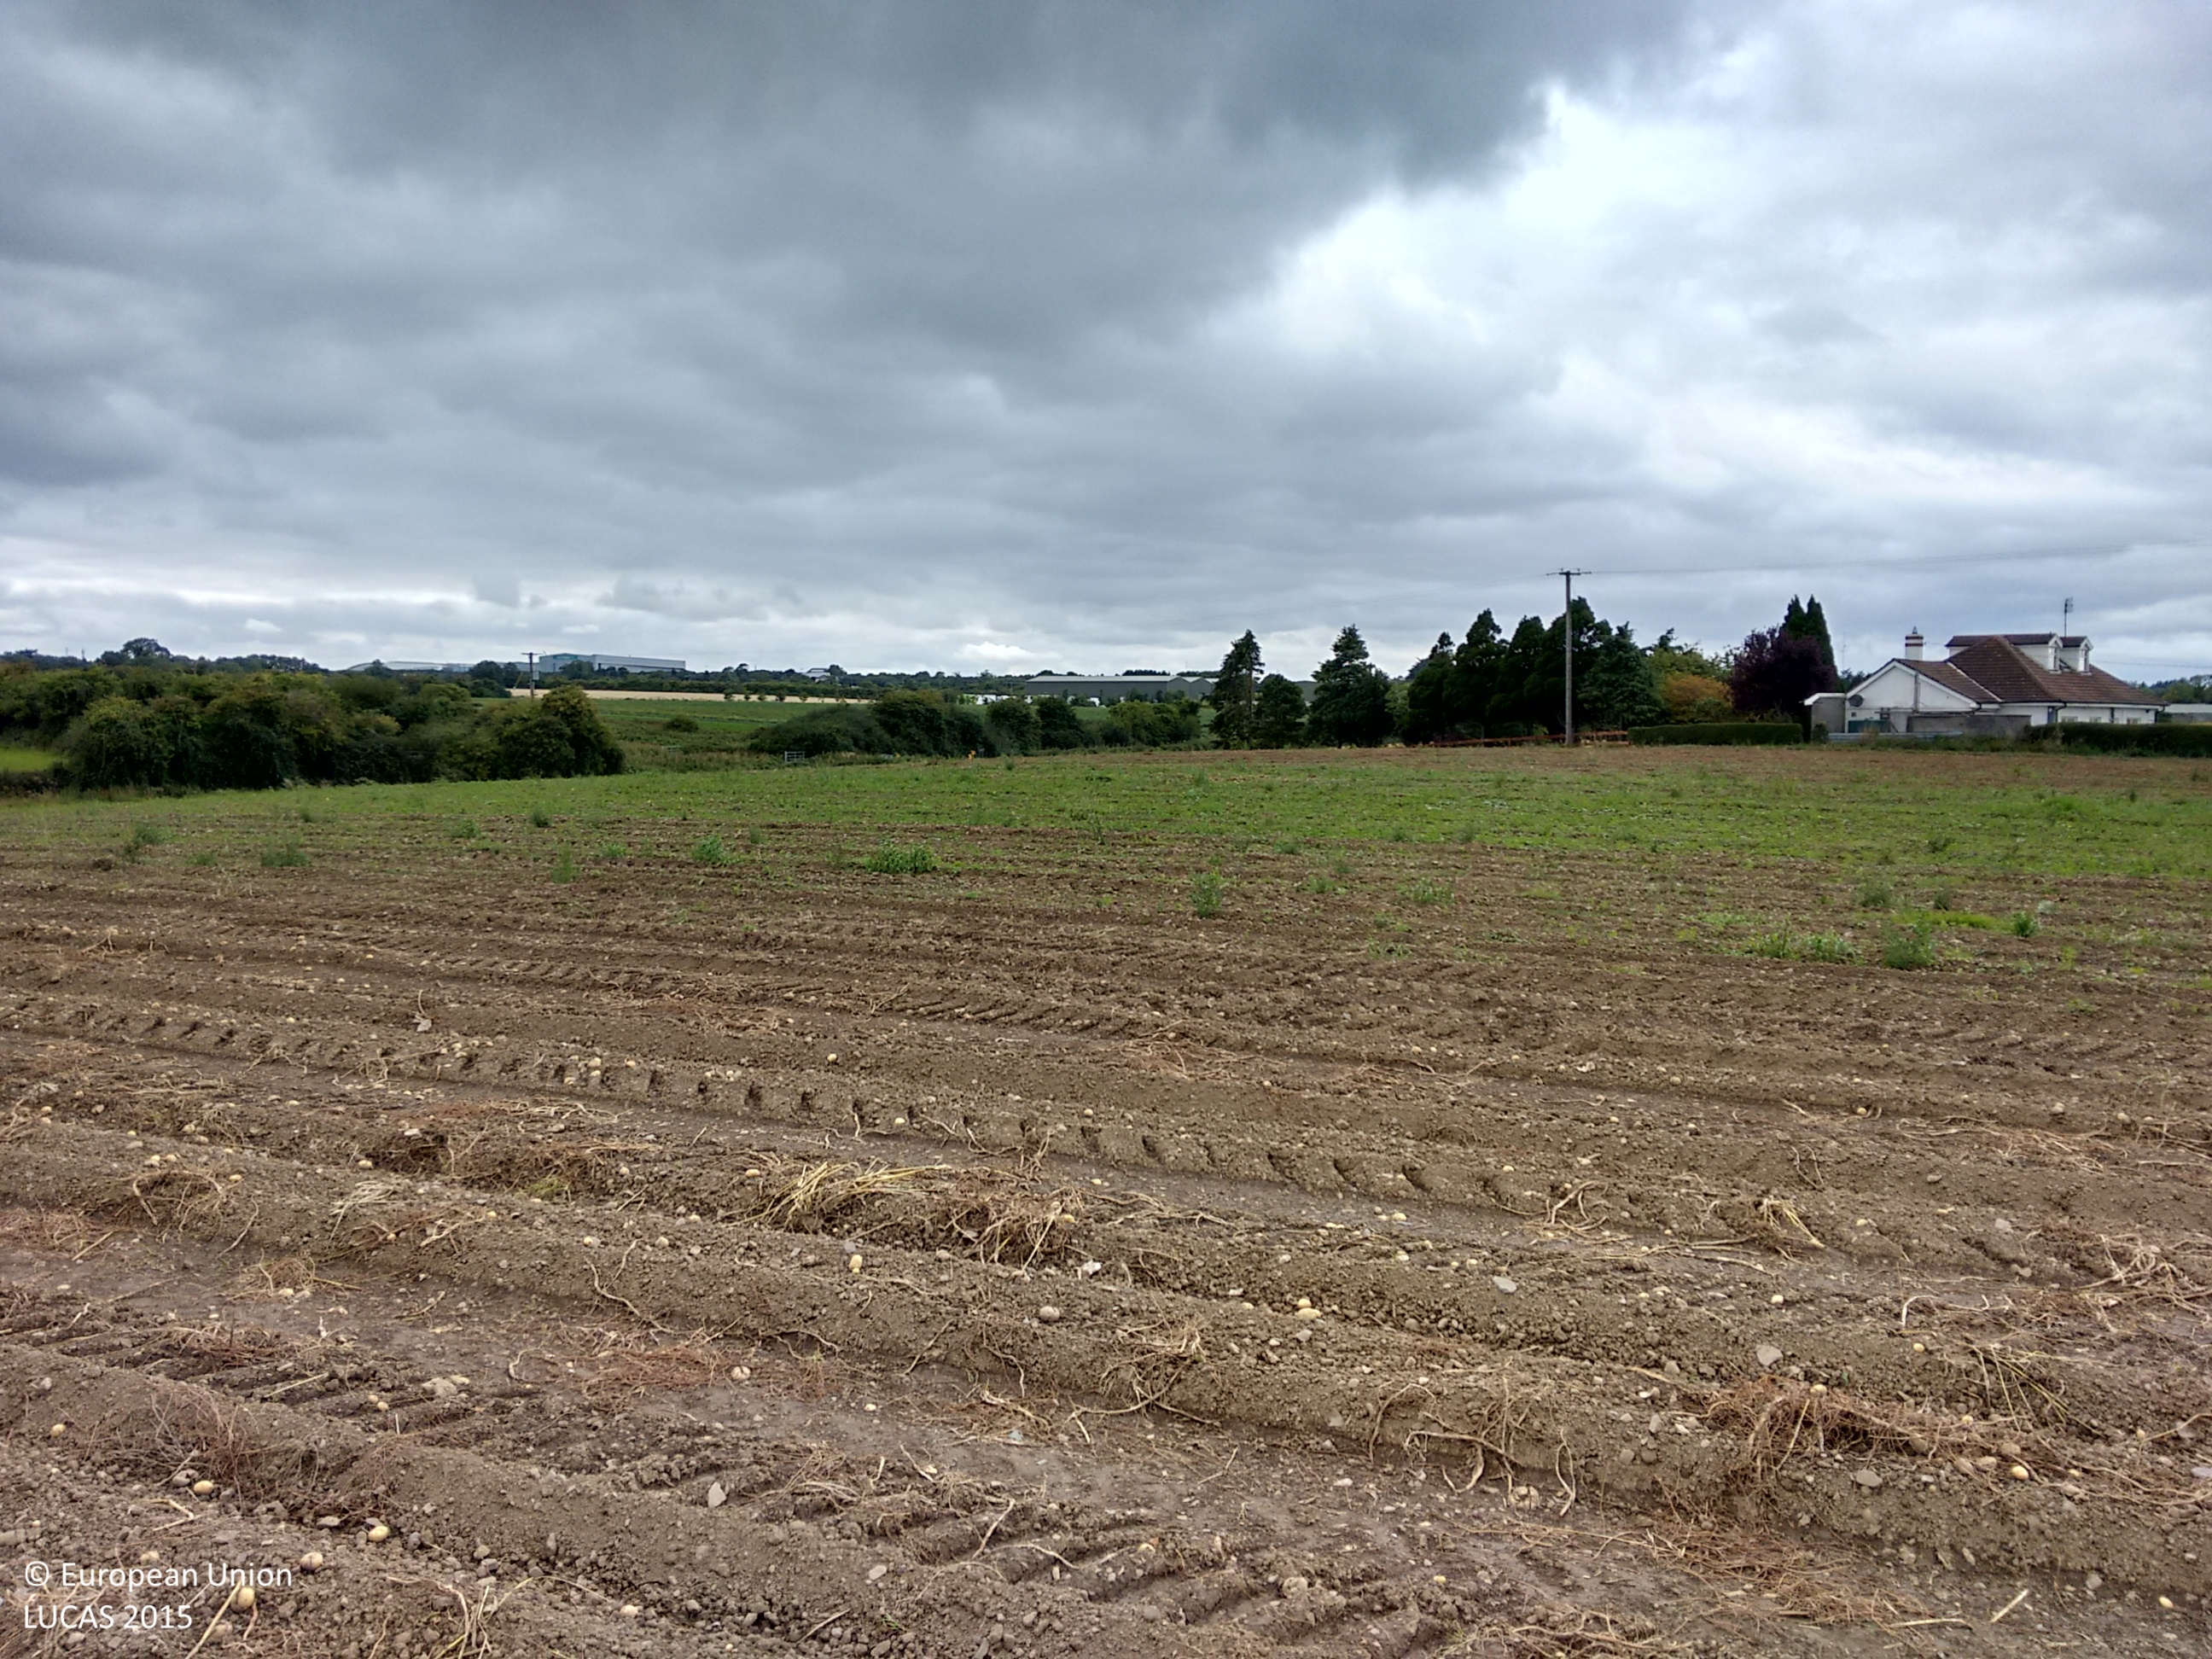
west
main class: Cropland
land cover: Potatoes
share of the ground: 10 - 25 %
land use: Agriculture (excluding fallow land and kitchen gardens)
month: September
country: IE
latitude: 53.4376
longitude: -6.2104
